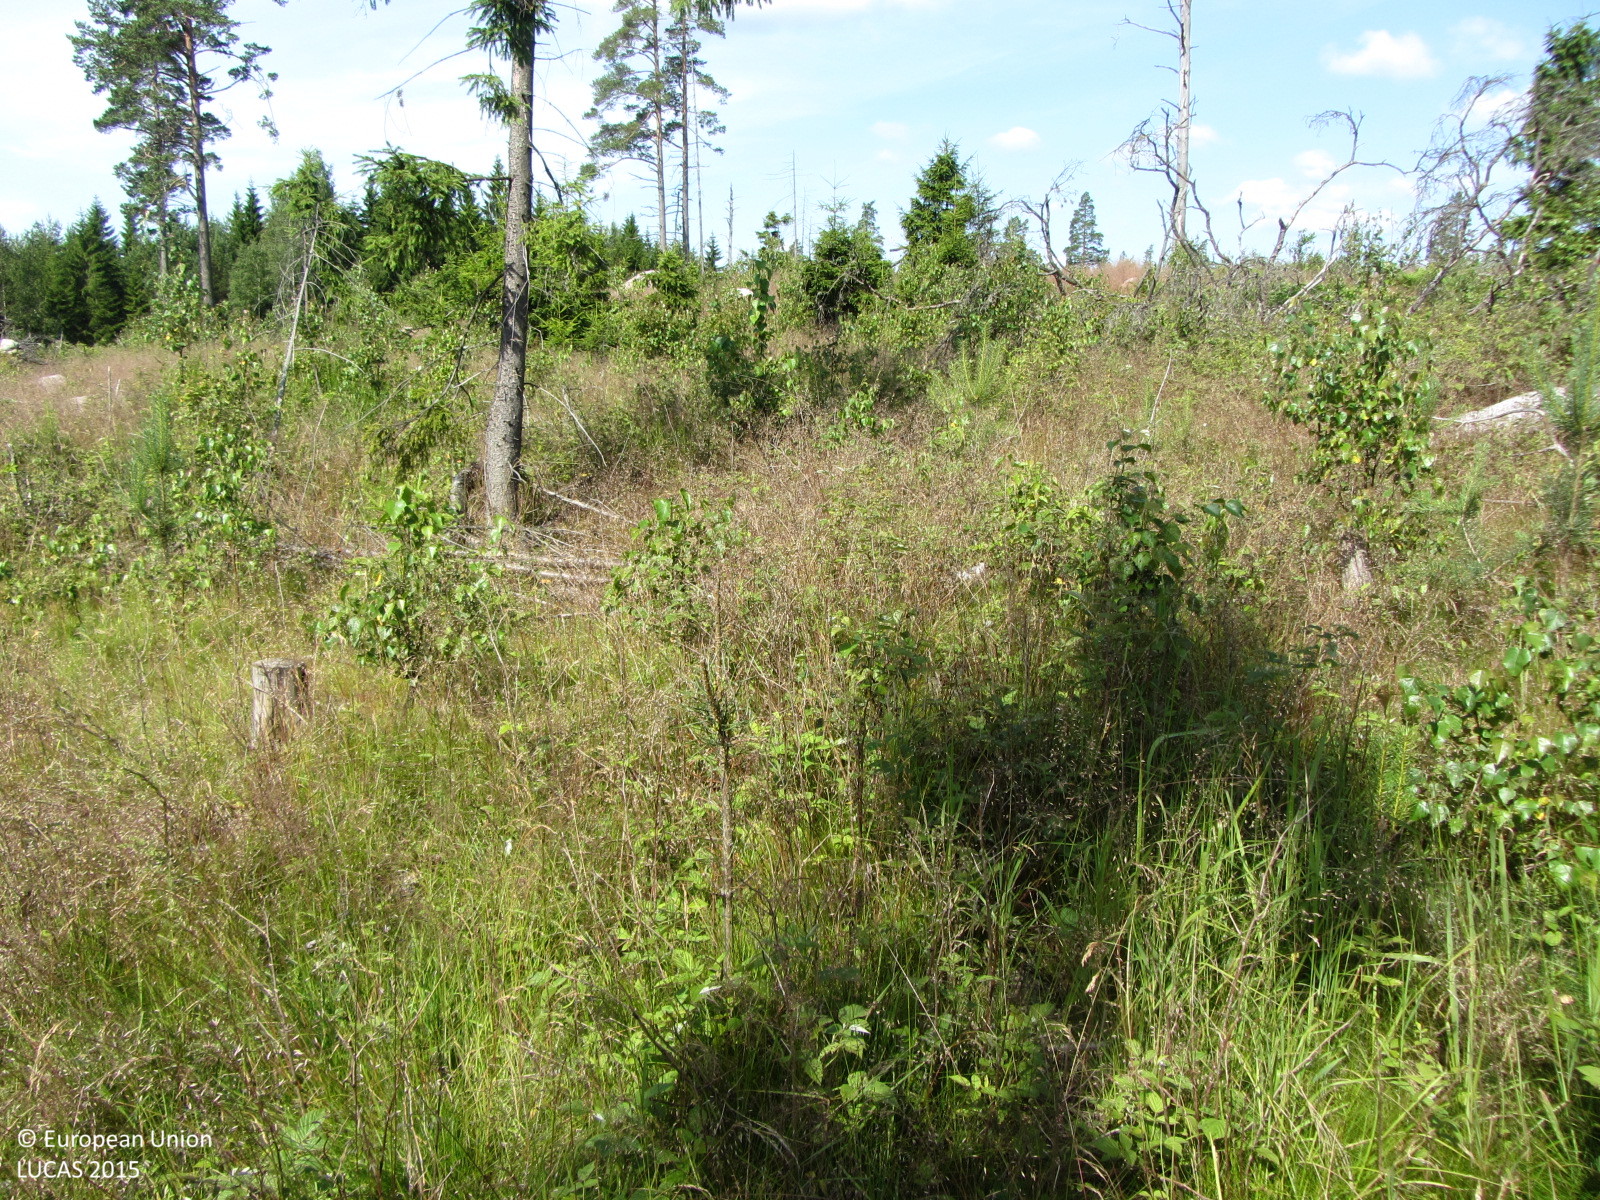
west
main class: Woodland
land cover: Spruce dominated mixed woodland
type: boreal forest
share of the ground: 25 - 50 %
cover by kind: herbaceous plants 60 %, broadleaved forest trees 15 %, shrubs 15 %, coniferous forest trees 10 %
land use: Forestry
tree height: < 5 m
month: July
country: FI
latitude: 60.0817
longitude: 24.5438
